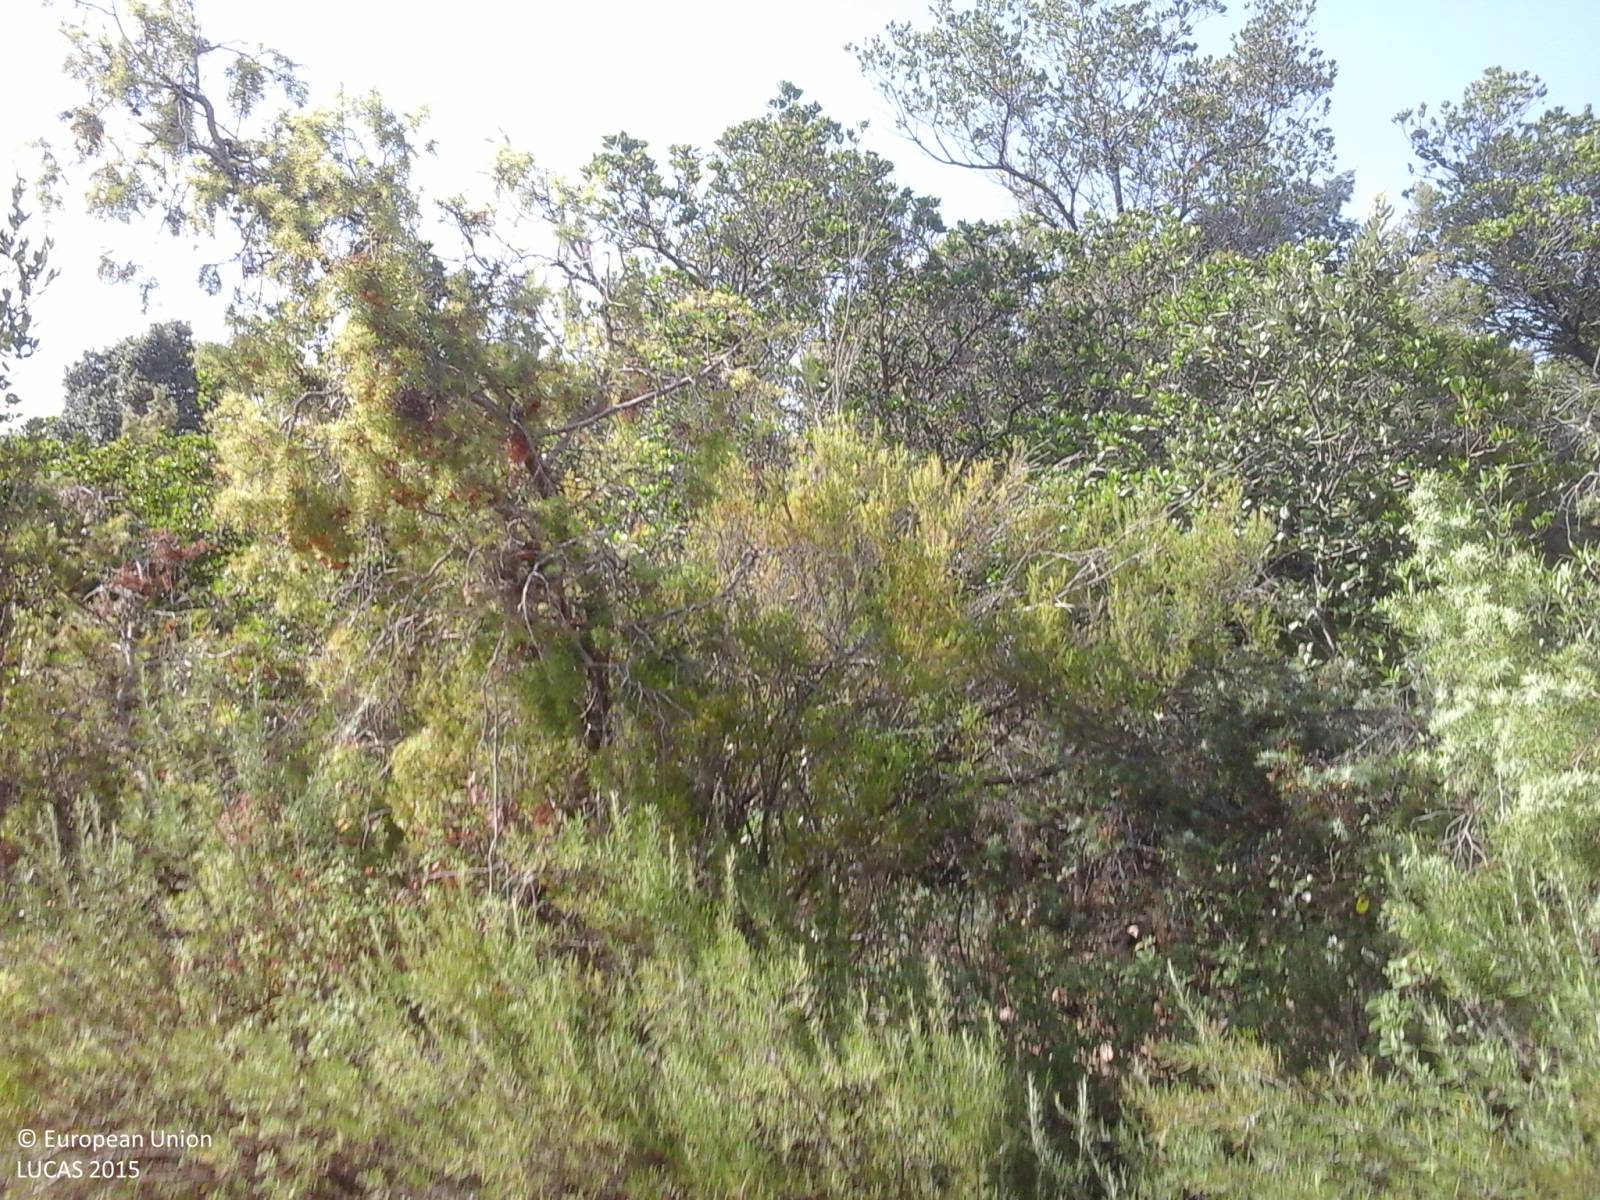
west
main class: Woodland
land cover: Broadleaved woodland
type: broadleaved evergreen forest
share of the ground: > 75 %
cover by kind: broadleaved forest trees 80 %, shrubs 15 %, herbaceous plants 5 %
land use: Semi-natural and natural areas not in use
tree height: > 5 m
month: September
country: IT
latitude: 39.8131
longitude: 9.4541
